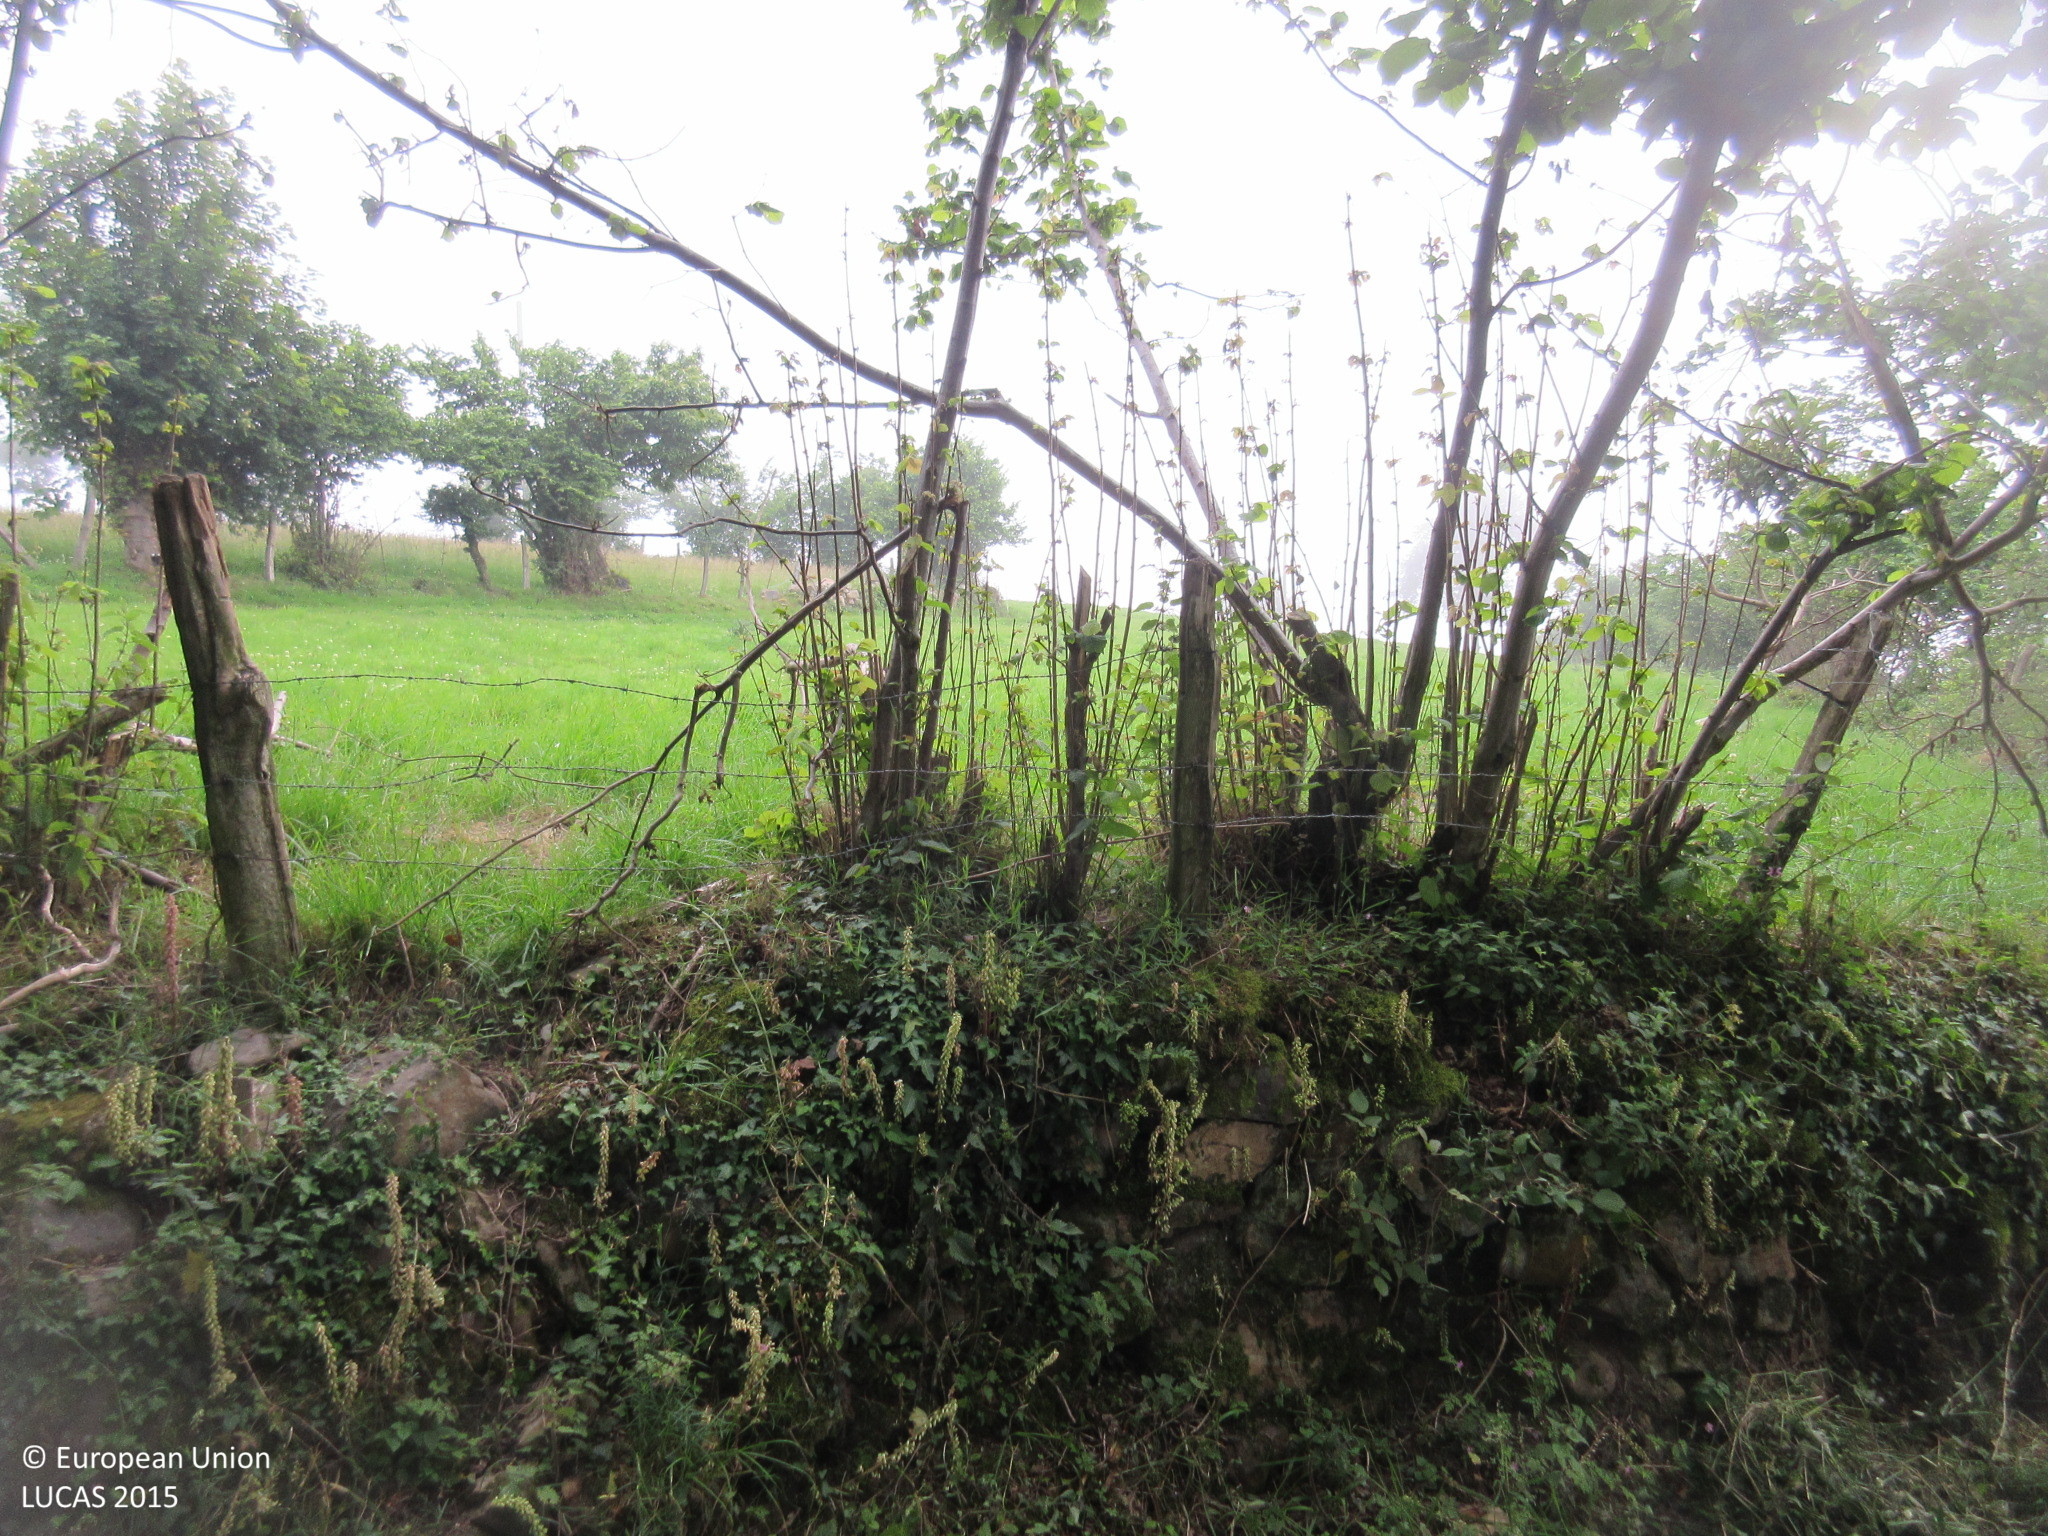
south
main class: Grassland
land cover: Grassland without tree/shrub cover
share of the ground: > 75 %
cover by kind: herbaceous plants 100 %
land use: Agriculture (excluding fallow land and kitchen gardens)
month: June
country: ES
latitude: 43.2893
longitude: -6.3044
